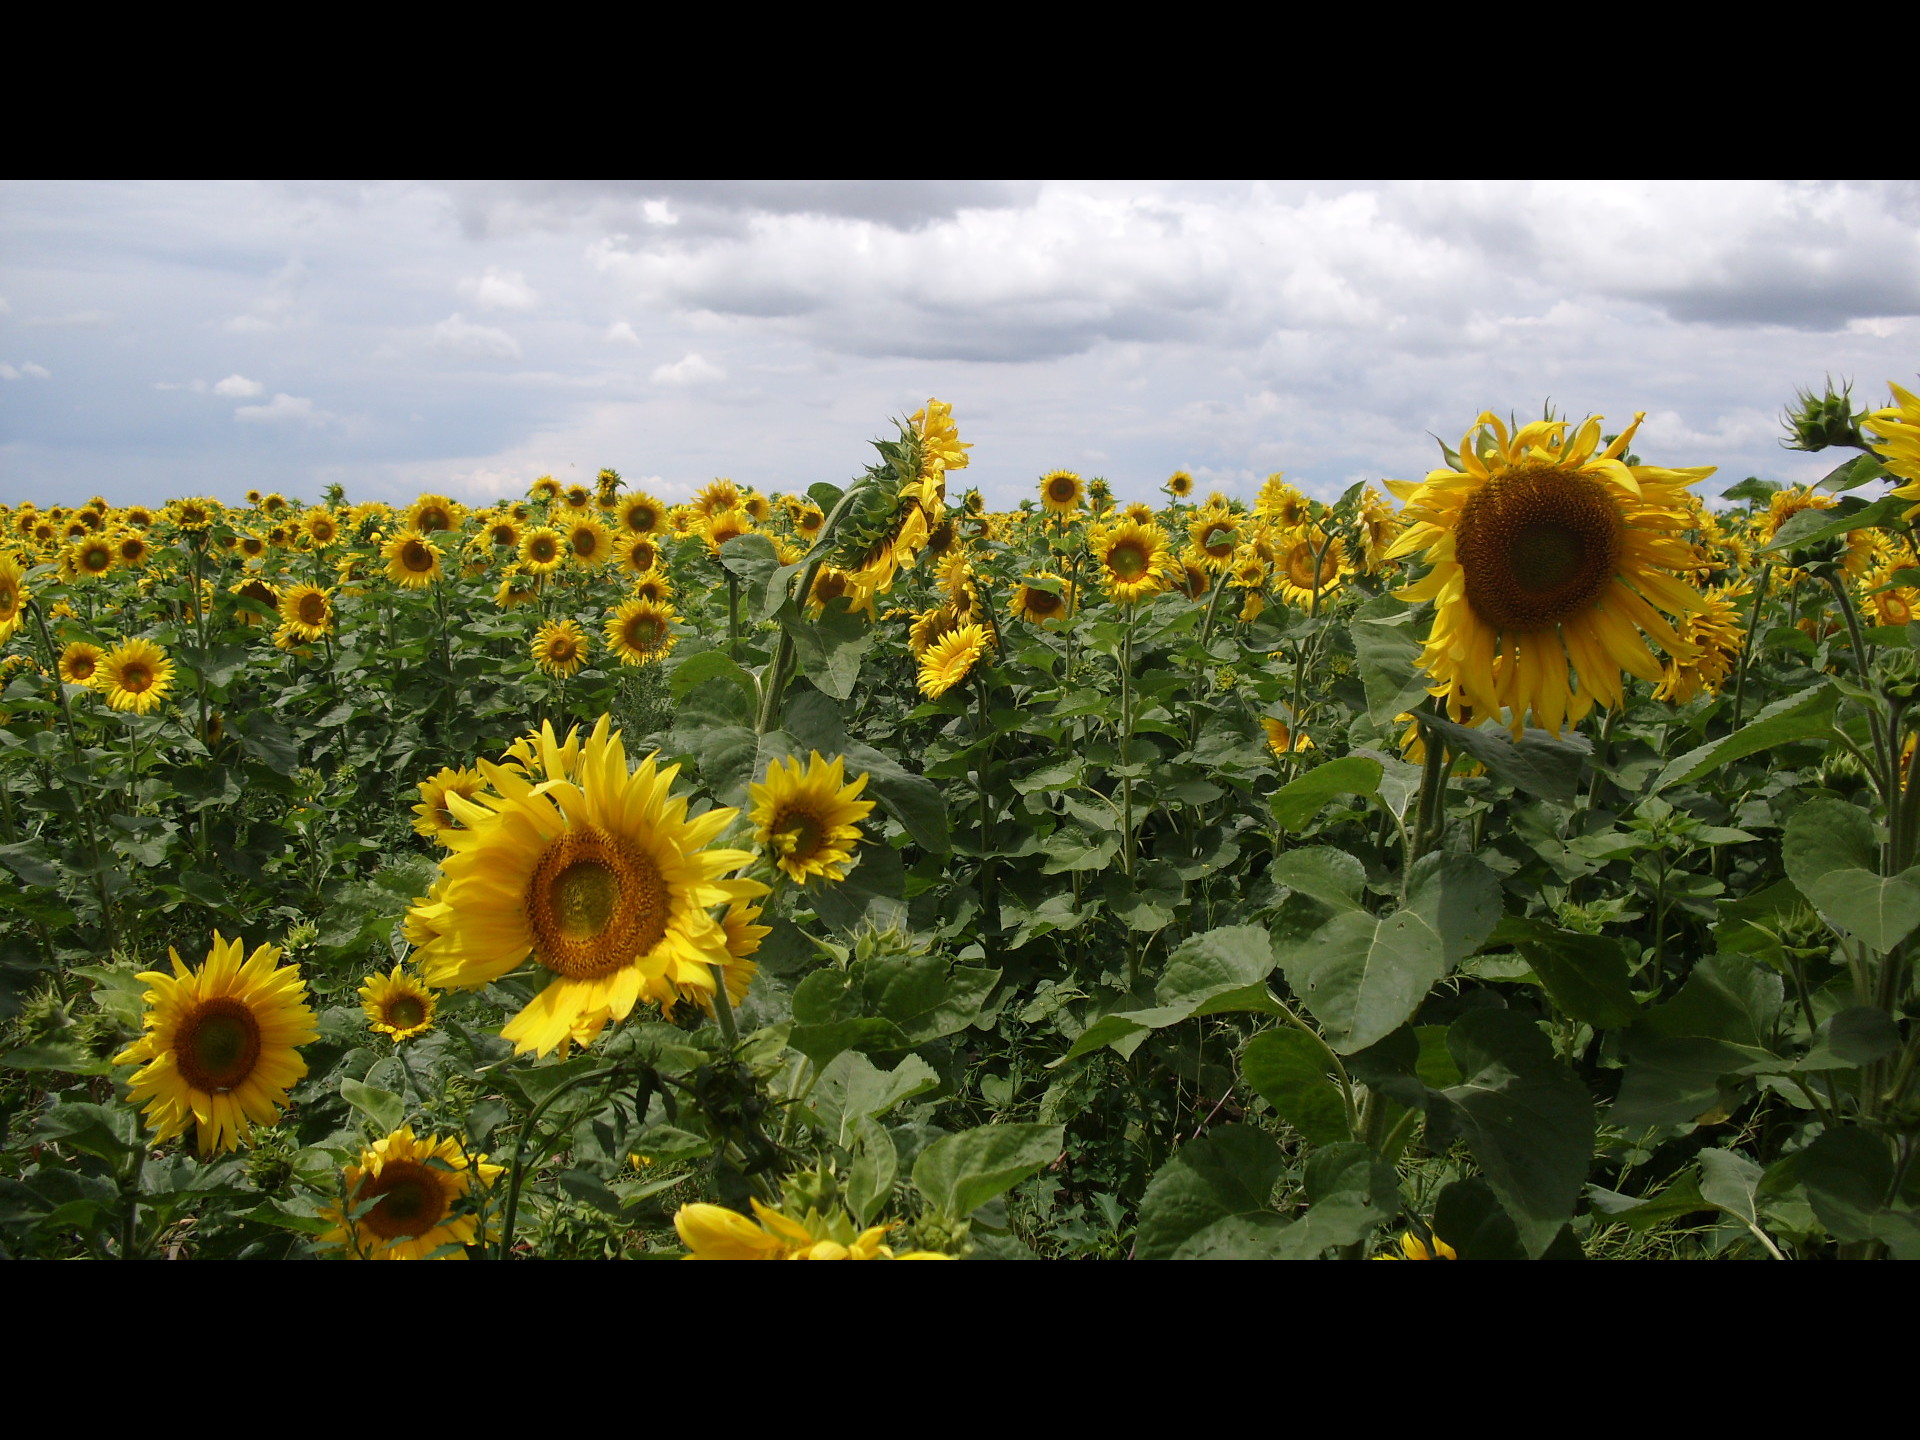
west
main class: Cropland
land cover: Sunflower
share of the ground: > 75 %
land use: Agriculture (excluding fallow land and kitchen gardens)
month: June
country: BG
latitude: 43.6226
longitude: 23.5419
